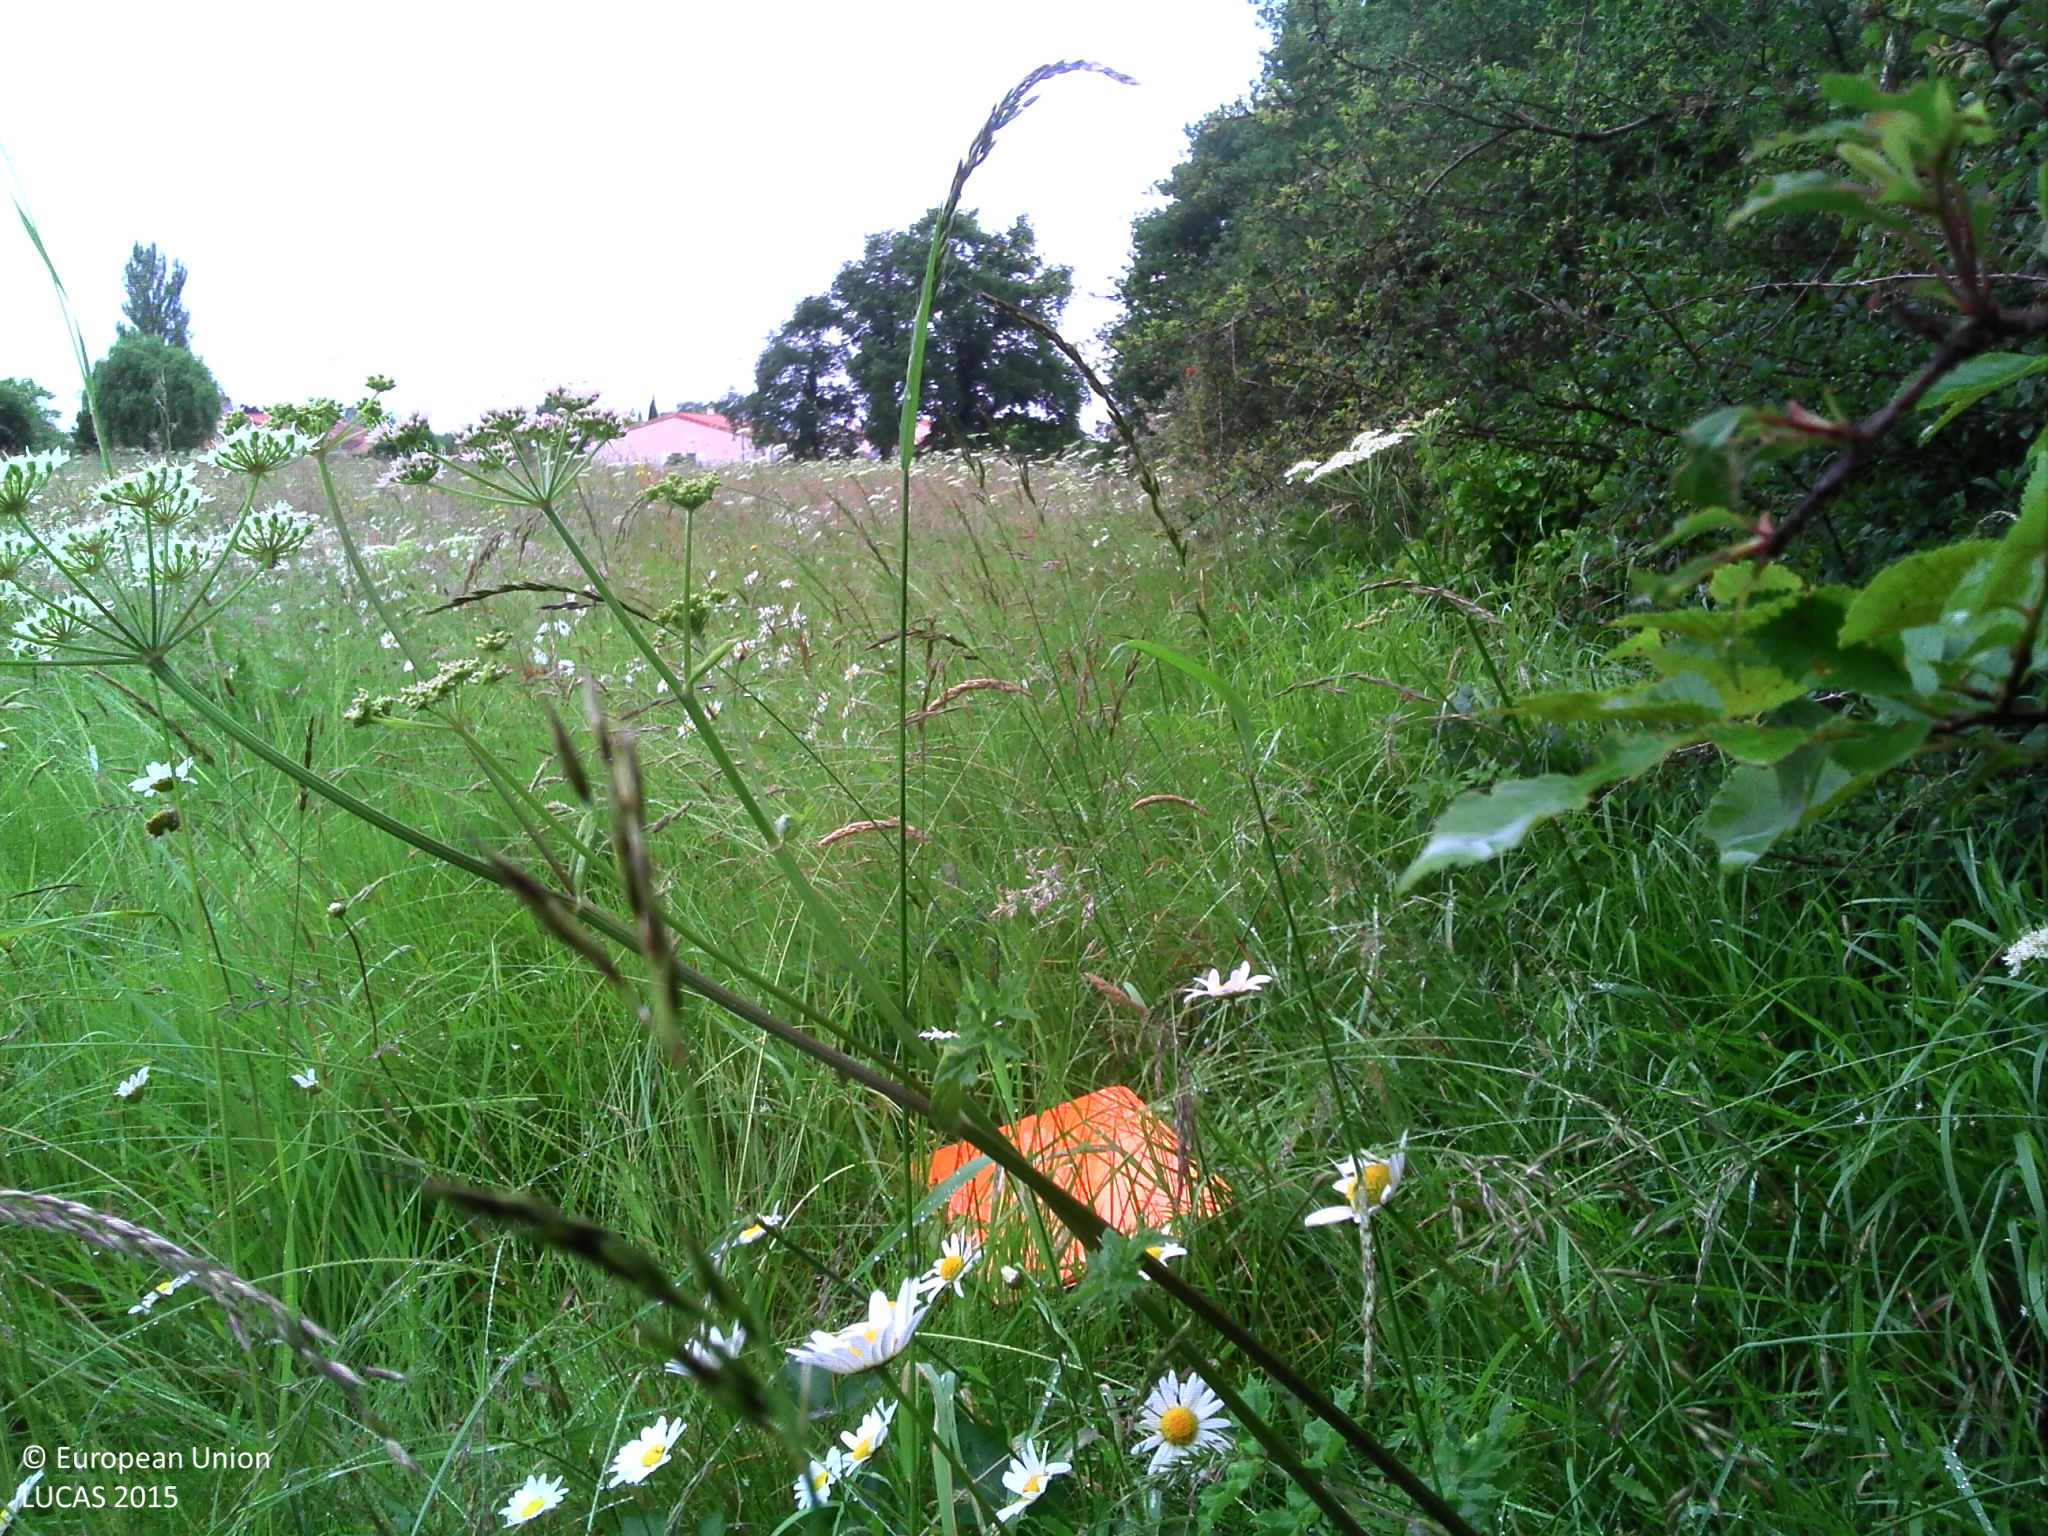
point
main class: Grassland
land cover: Grassland without tree/shrub cover
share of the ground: > 75 %
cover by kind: herbaceous plants 100 %
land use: Agriculture (excluding fallow land and kitchen gardens)
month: June
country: FR
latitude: 47.1716
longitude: -1.2658
